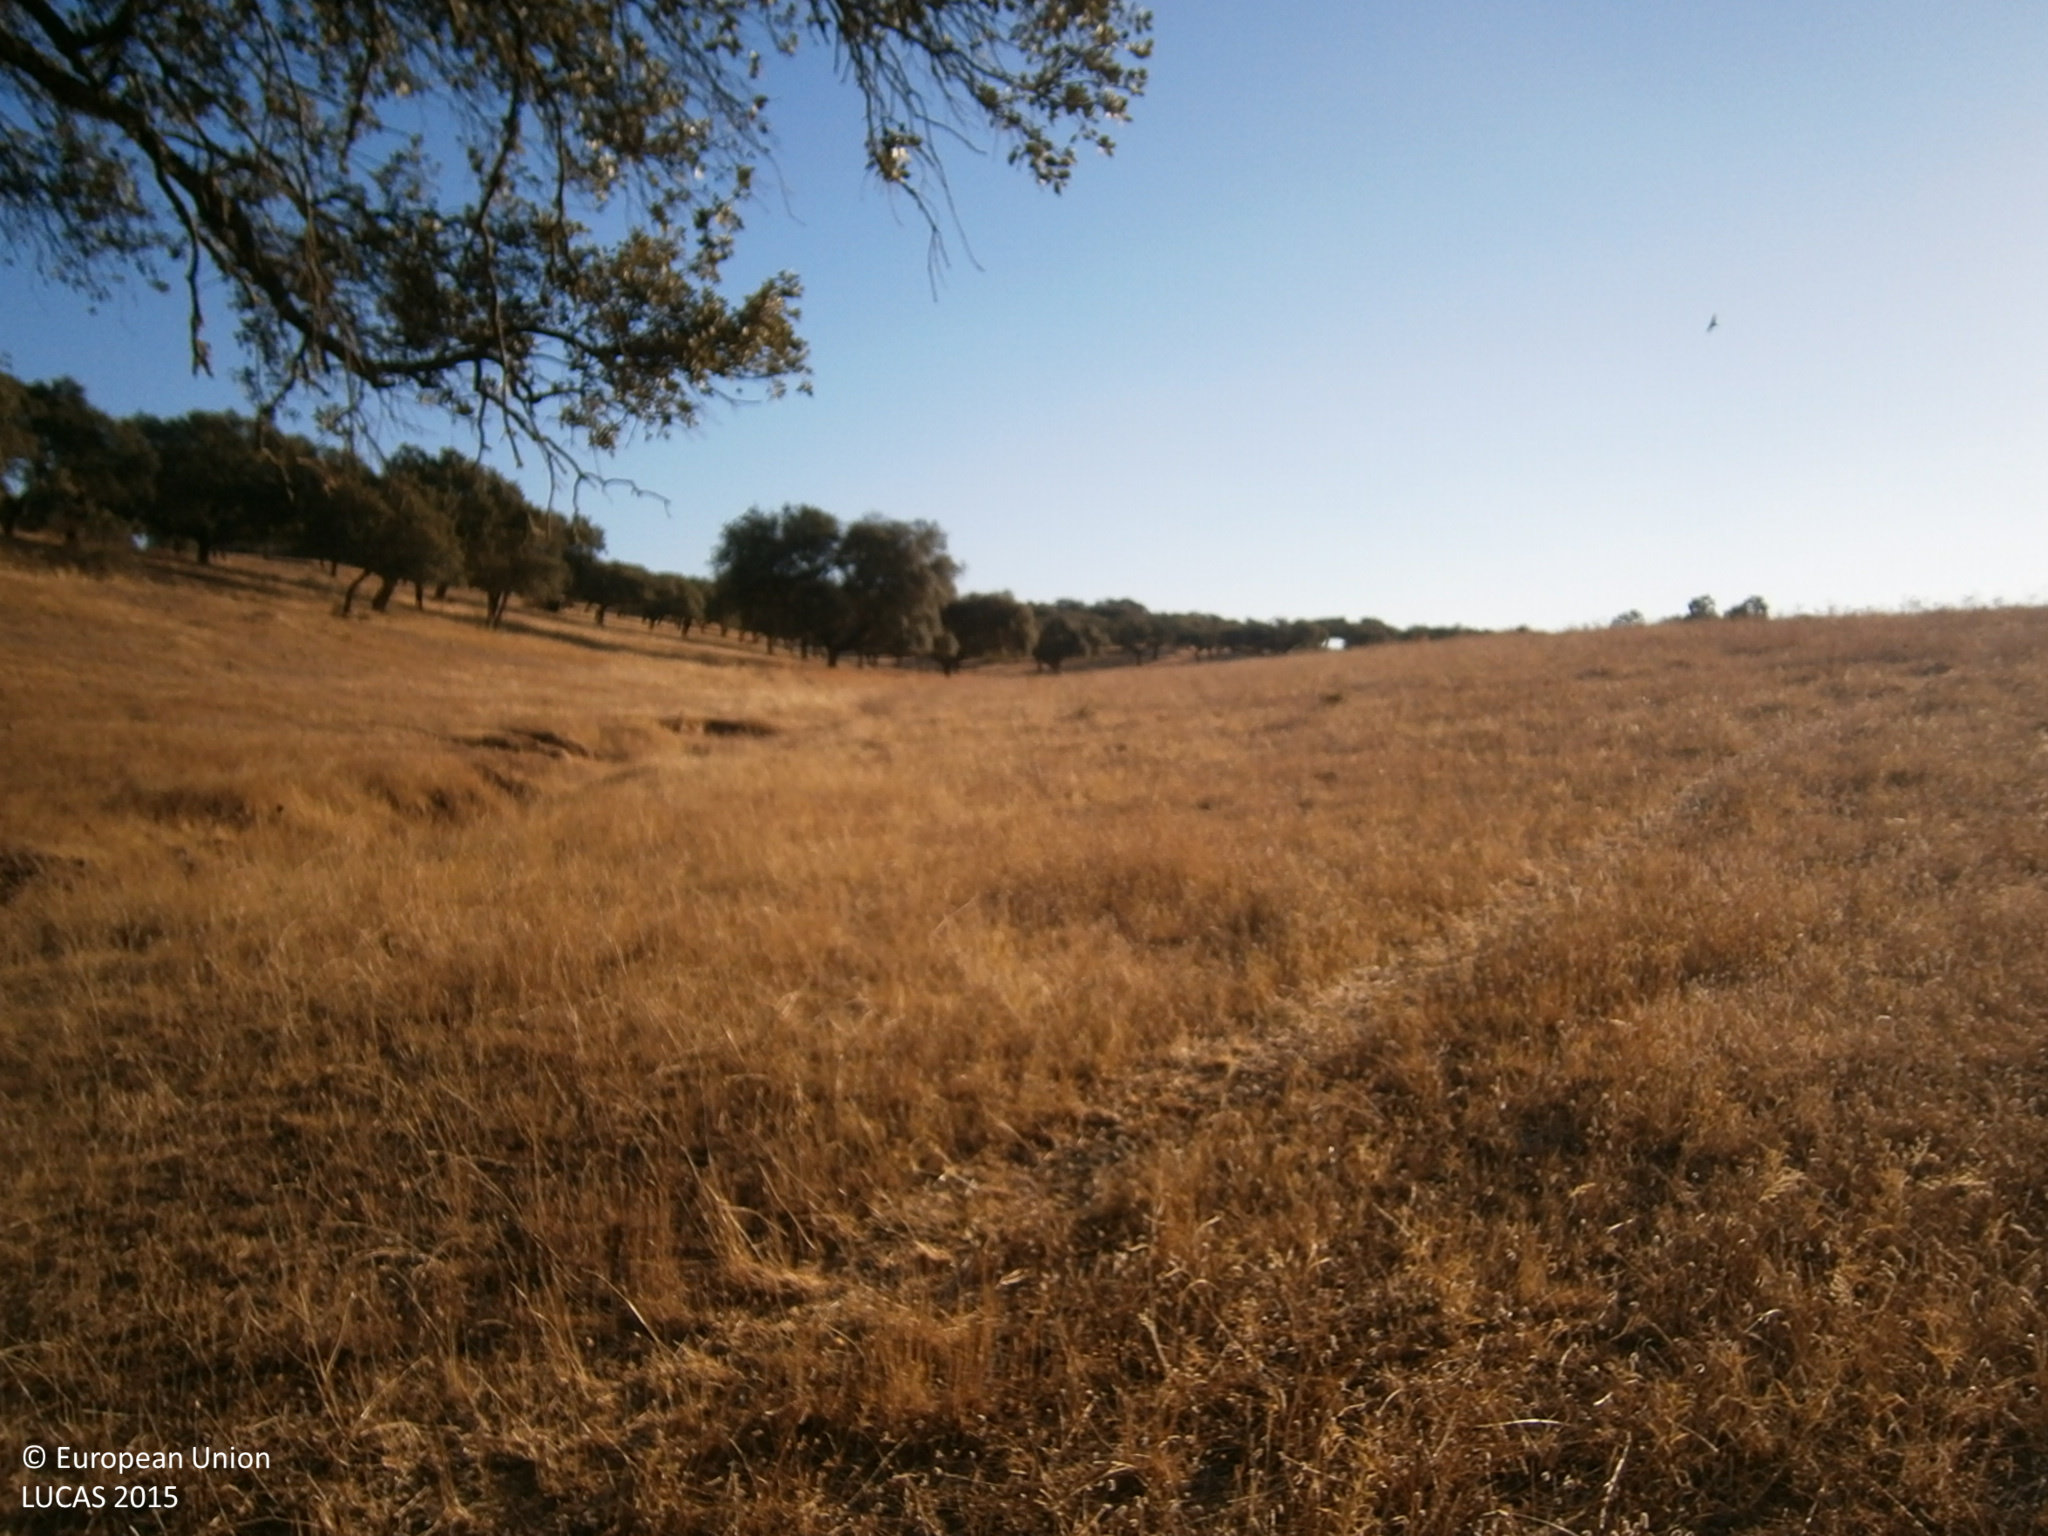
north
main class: Woodland
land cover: Broadleaved woodland
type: broadleaved evergreen forest
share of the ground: 50 - 75 %
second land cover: Spontaneously vegetated surfaces
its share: > 75 %
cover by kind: broadleaved forest trees 65 %, herbaceous plants 35 %
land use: Forestry
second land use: Agriculture (excluding fallow land and kitchen gardens)
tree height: > 5 m
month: July
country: ES
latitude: 38.6701
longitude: -7.2549
